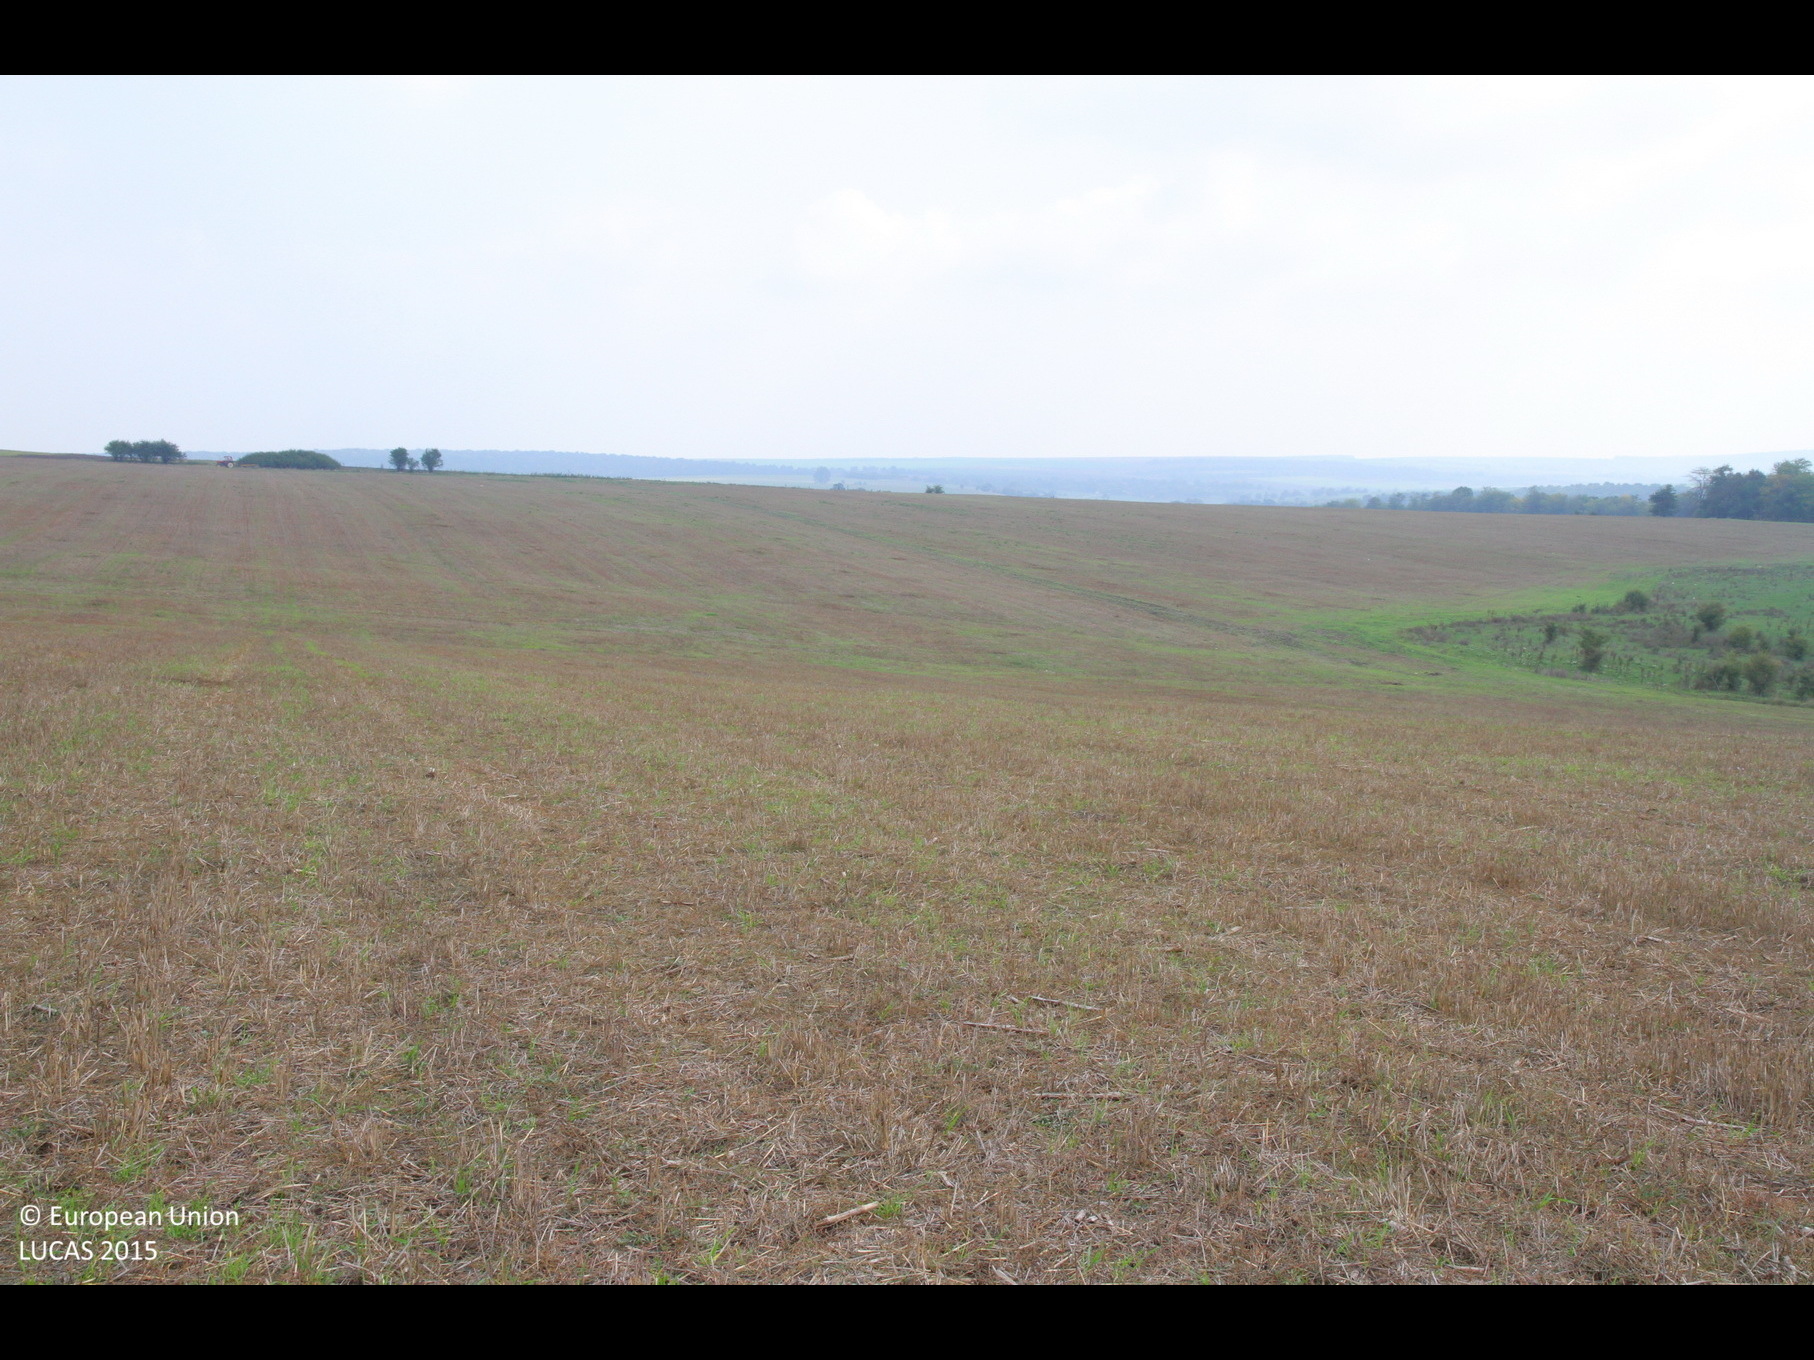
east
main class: Cropland
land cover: Common wheat
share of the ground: < 10 %
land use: Agriculture (excluding fallow land and kitchen gardens)
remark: Harvested field
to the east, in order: Common wheat
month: October
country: BG
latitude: 43.5757
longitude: 27.0216
